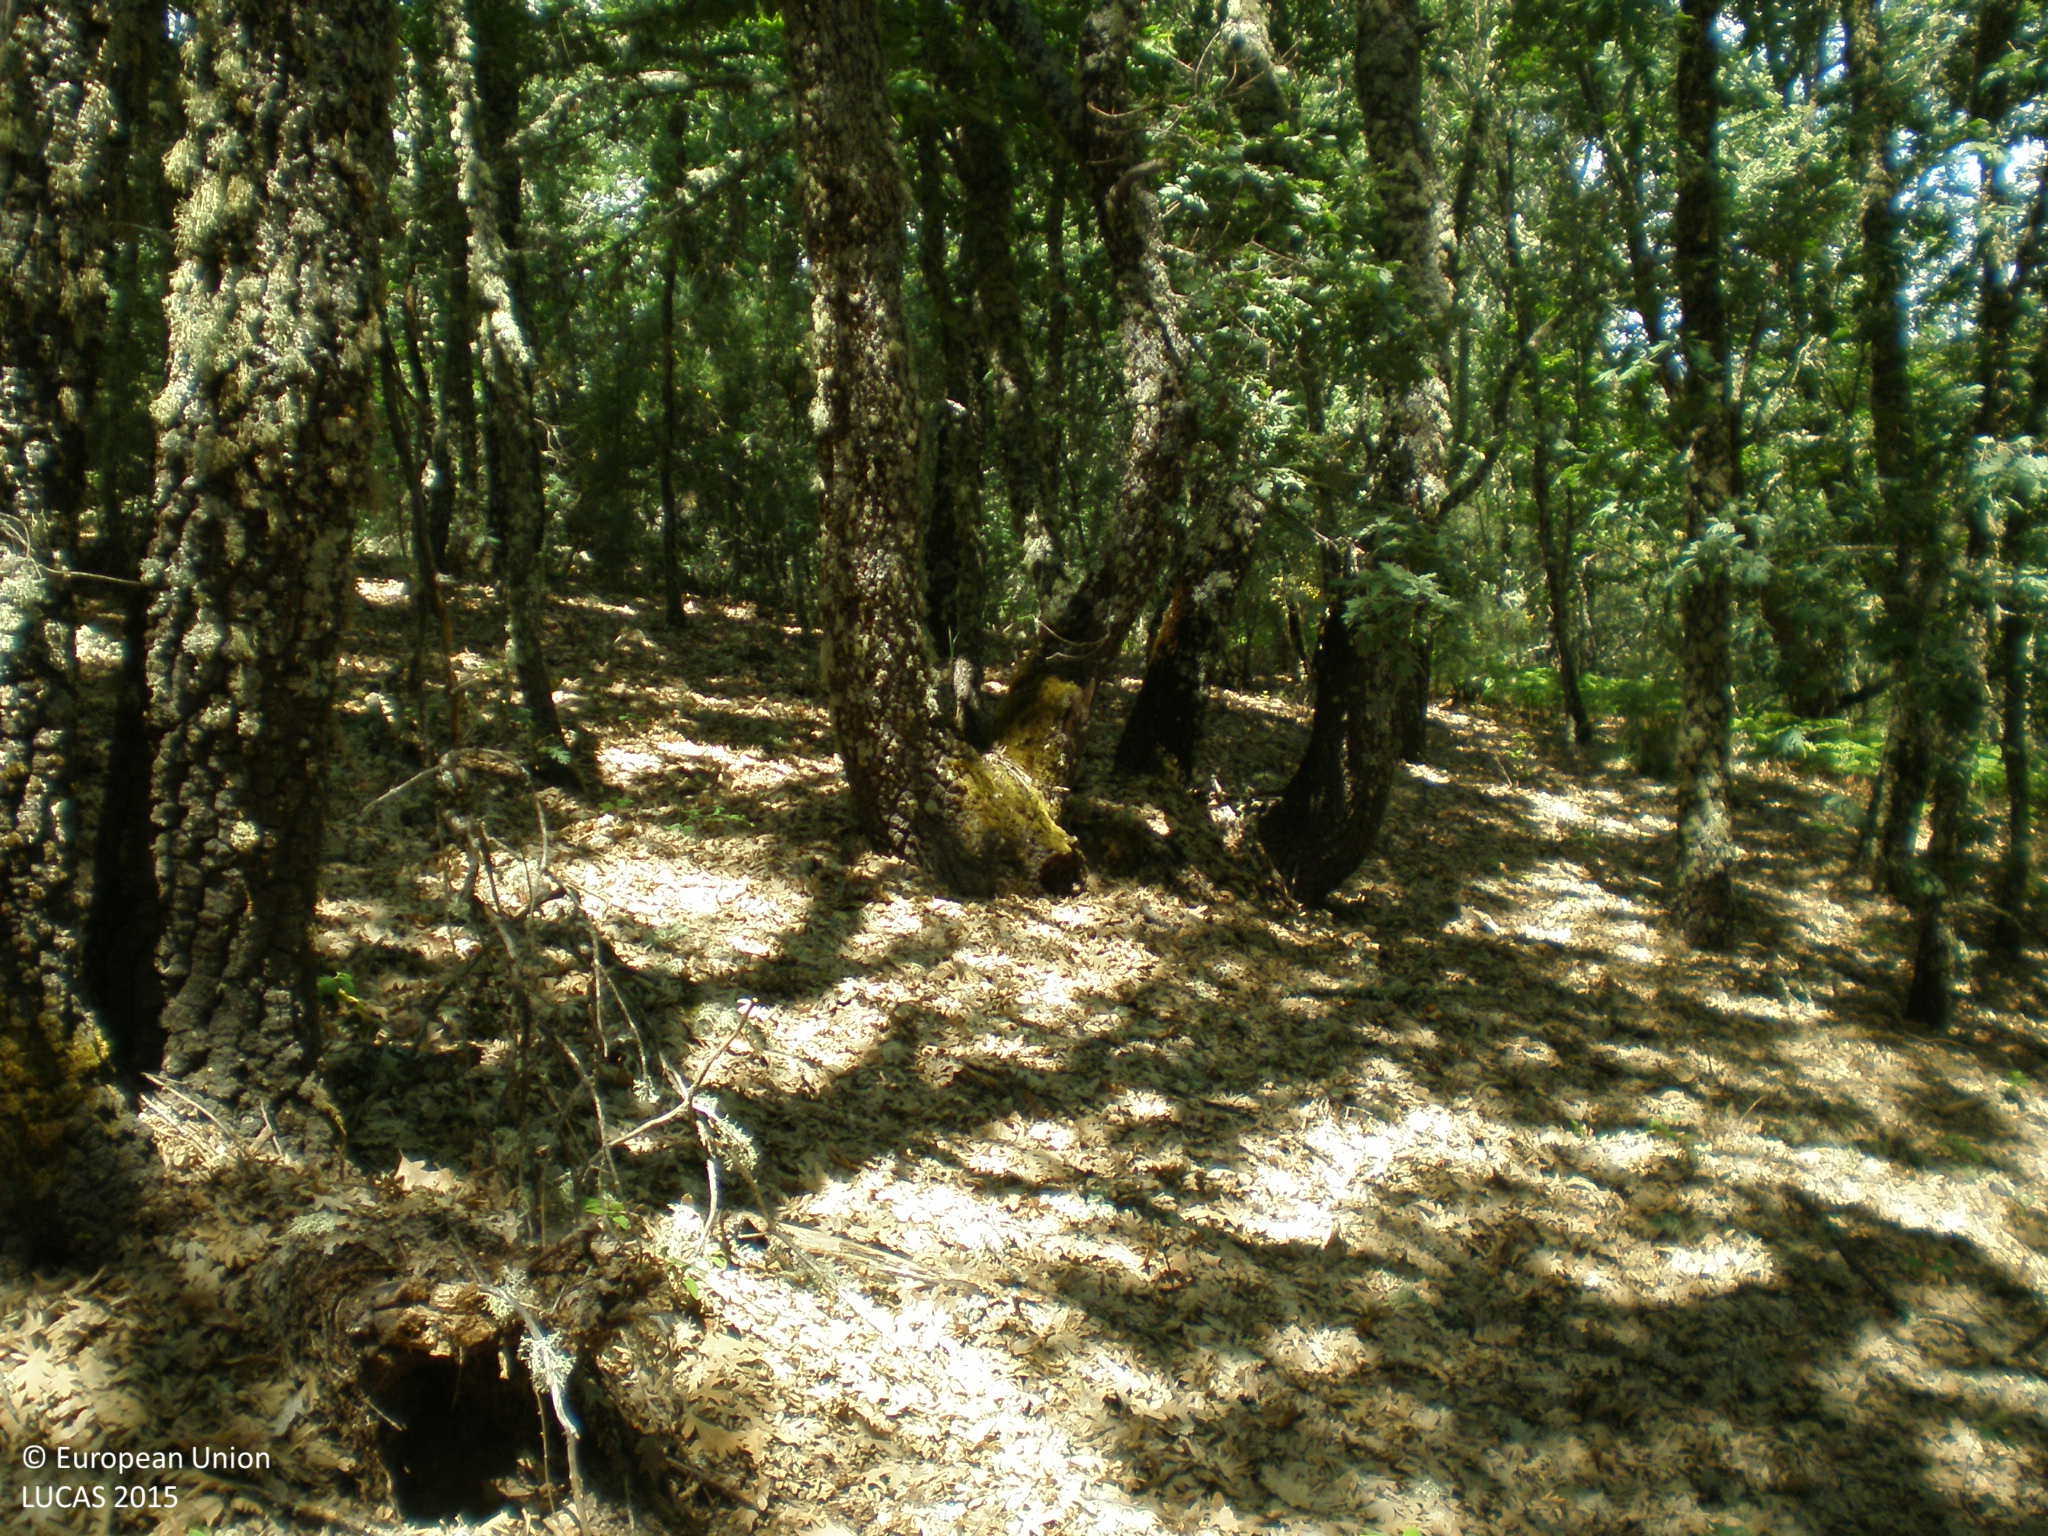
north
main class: Woodland
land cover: Broadleaved woodland
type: thermophilous deciduous forest
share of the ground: > 75 %
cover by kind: broadleaved forest trees 100 %
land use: Forestry
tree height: > 5 m
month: June
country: ES
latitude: 40.3217
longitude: -5.5652
